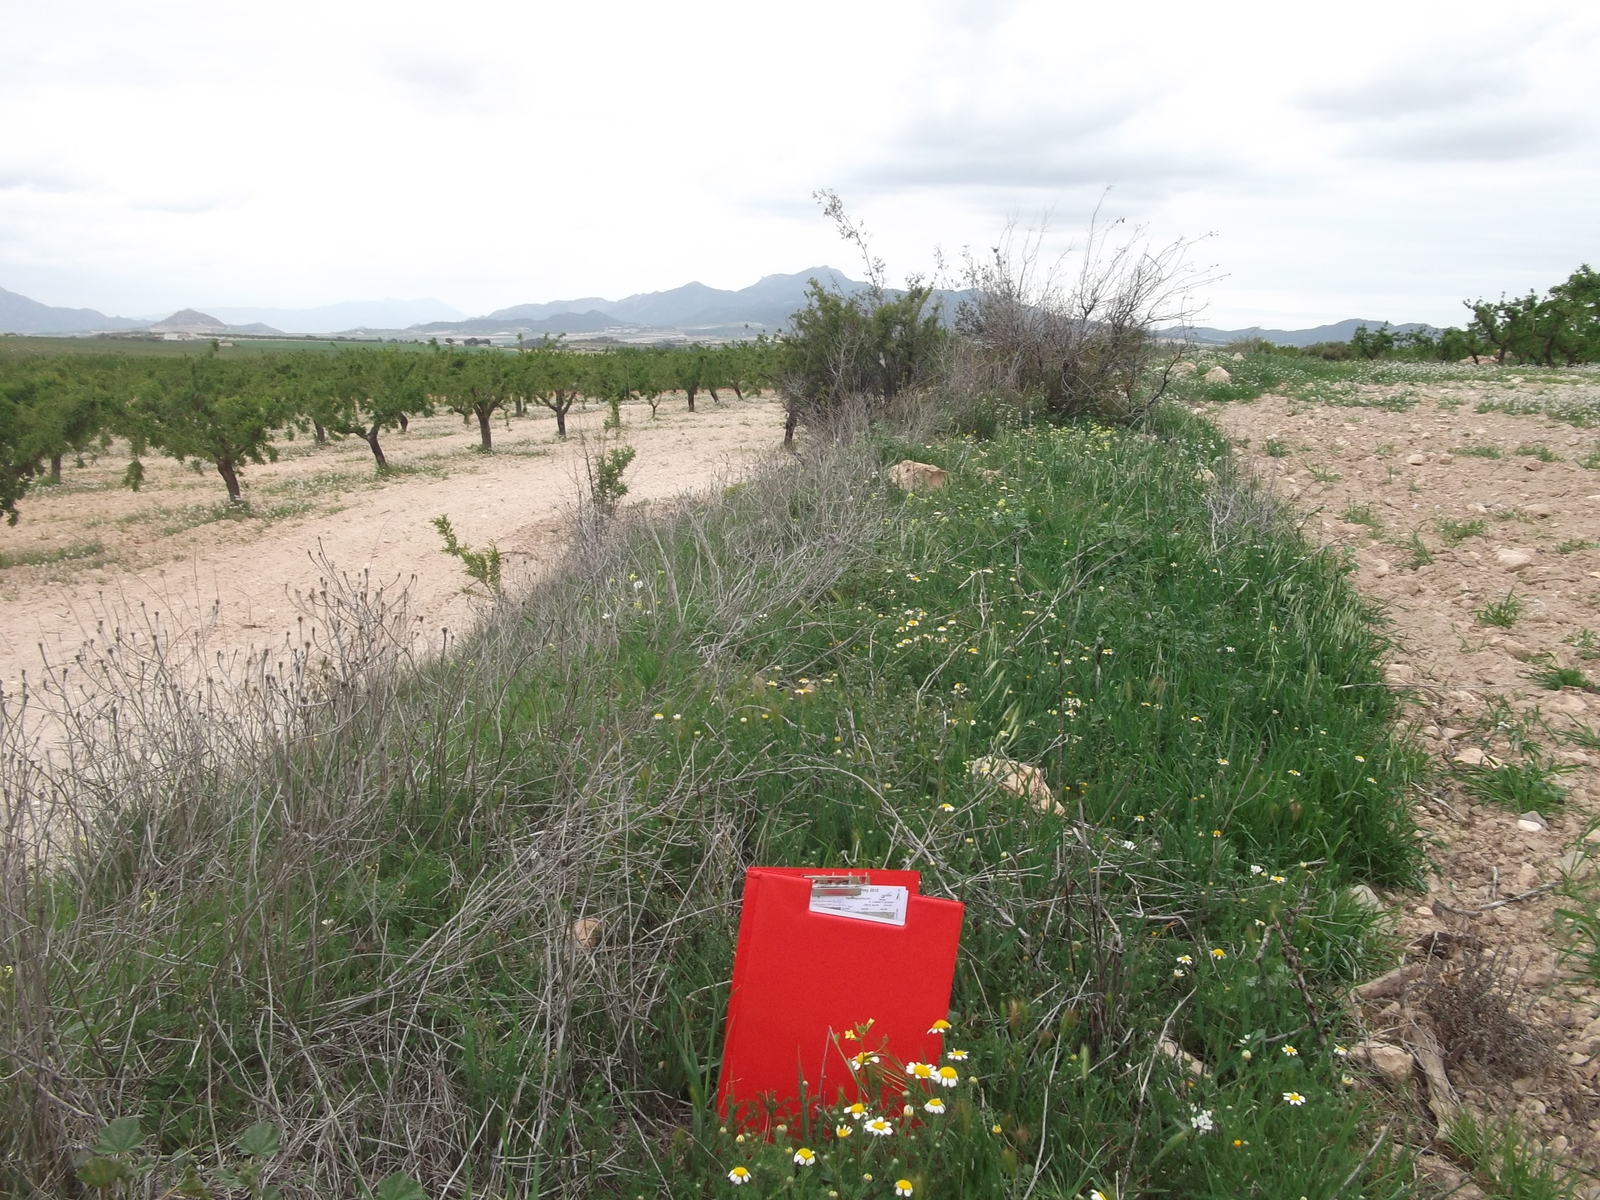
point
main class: Shrubland
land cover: Shrubland without tree cover
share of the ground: 25 - 50 %
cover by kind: shrubs 50 %, herbaceous plants 50 %
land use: Abandoned areas
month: April
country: ES
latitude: 38.0983
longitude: -1.5846
